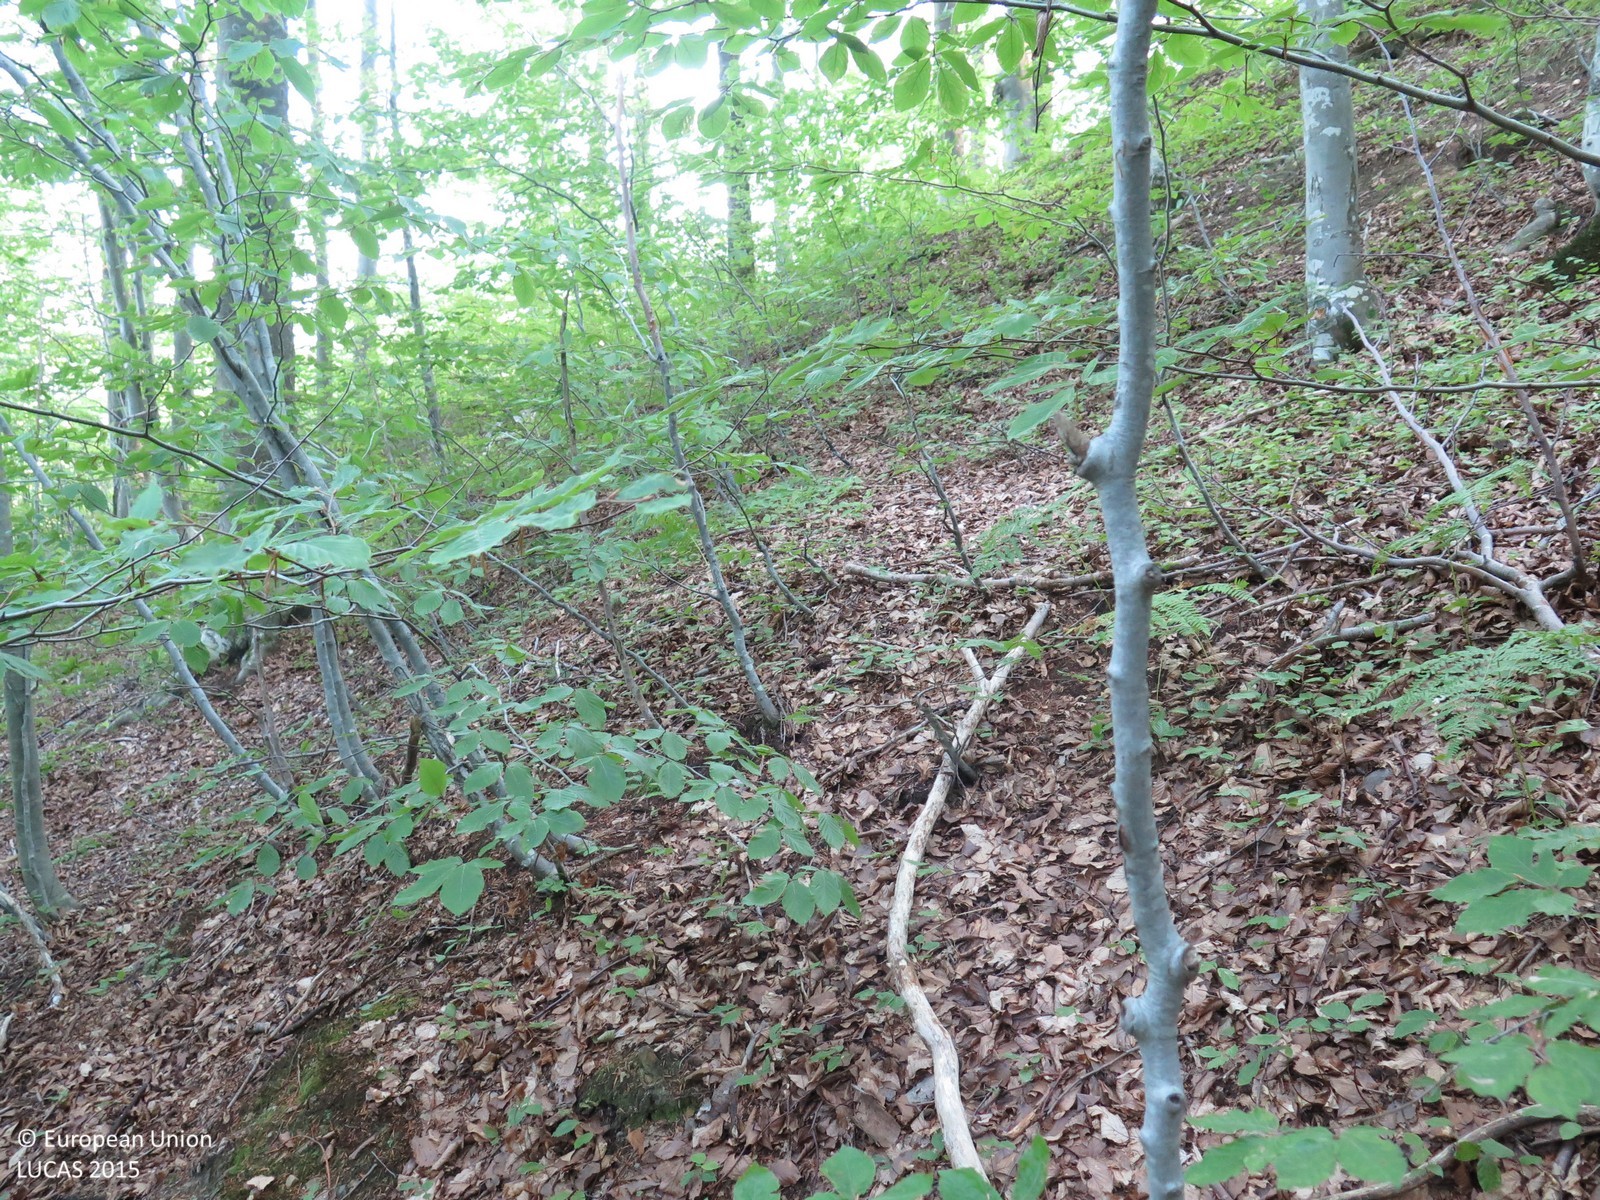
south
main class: Woodland
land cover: Broadleaved woodland
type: beech forest
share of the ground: > 75 %
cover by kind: broadleaved forest trees 95 %, lichens and mosses 5 %
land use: Forestry
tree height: > 5 m
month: August
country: HR
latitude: 45.4416
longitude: 14.9686
